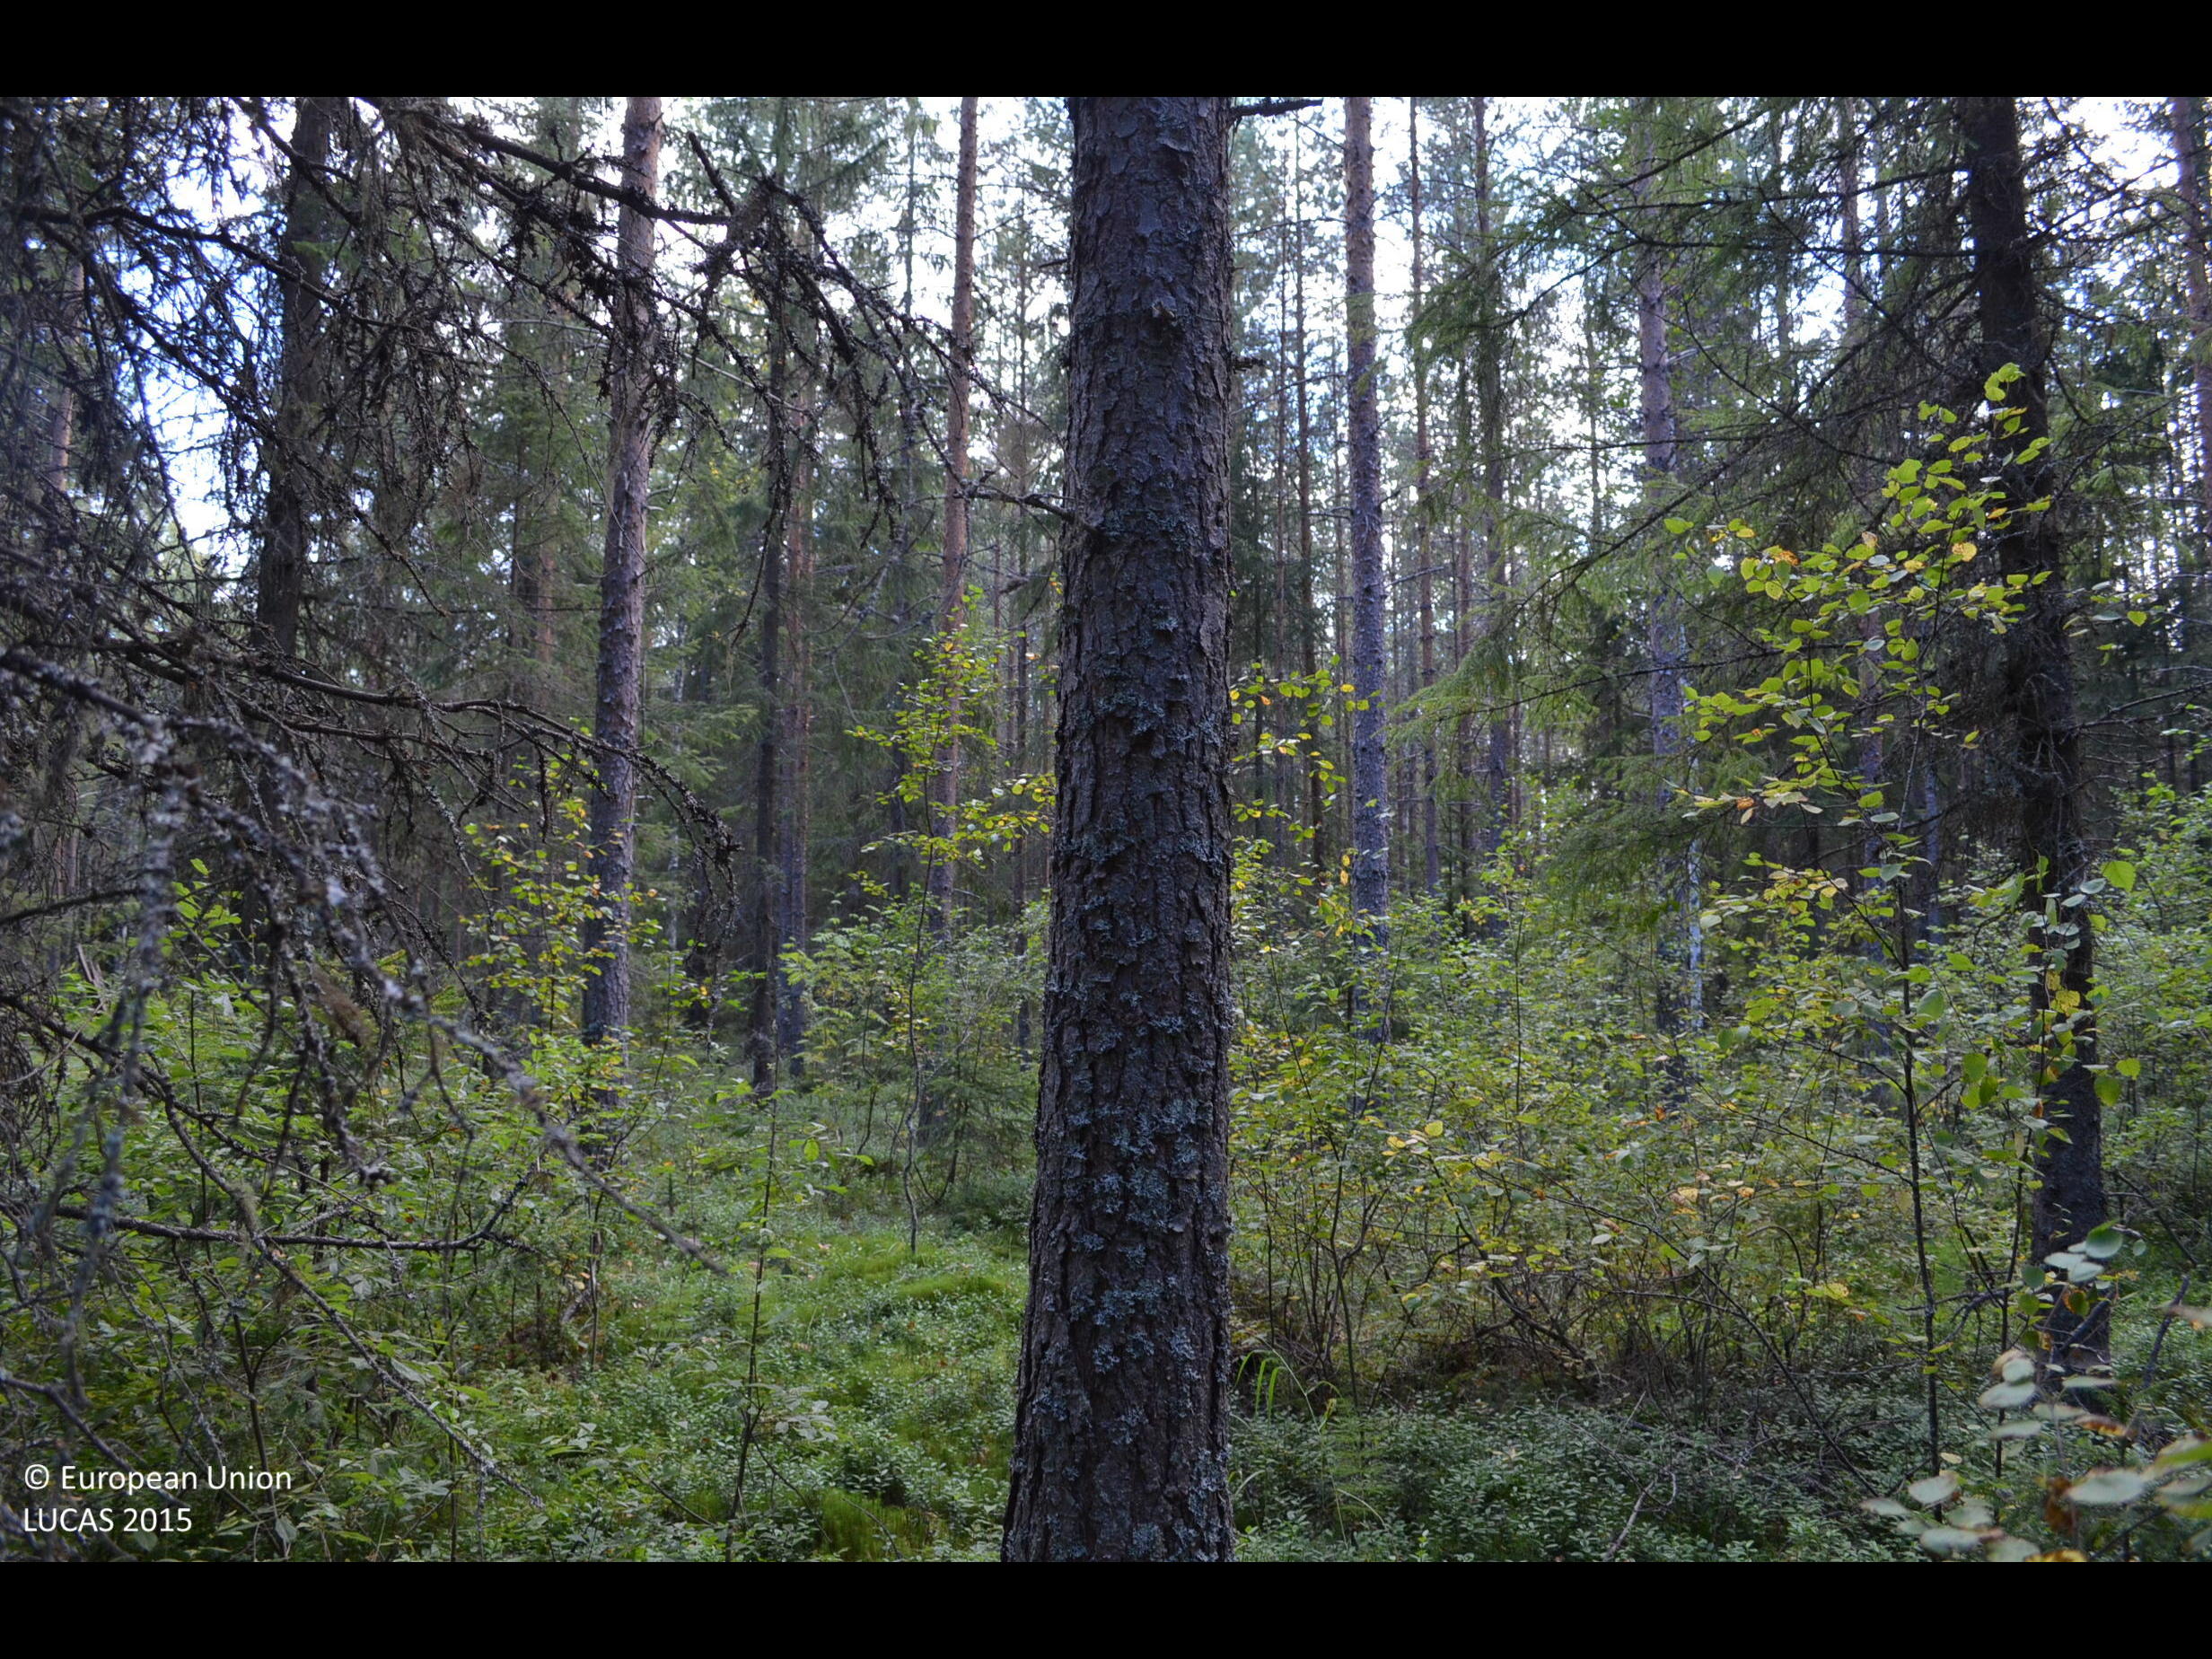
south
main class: Woodland
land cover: Other coniferous woodland
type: boreal forest
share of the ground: > 75 %
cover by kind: coniferous forest trees 70 %, shrubs 15 %, broadleaved forest trees 5 %, herbaceous plants 5 %, lichens and mosses 5 %
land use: Forestry
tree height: > 5 m
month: August
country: FI
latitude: 62.3779
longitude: 23.5878
